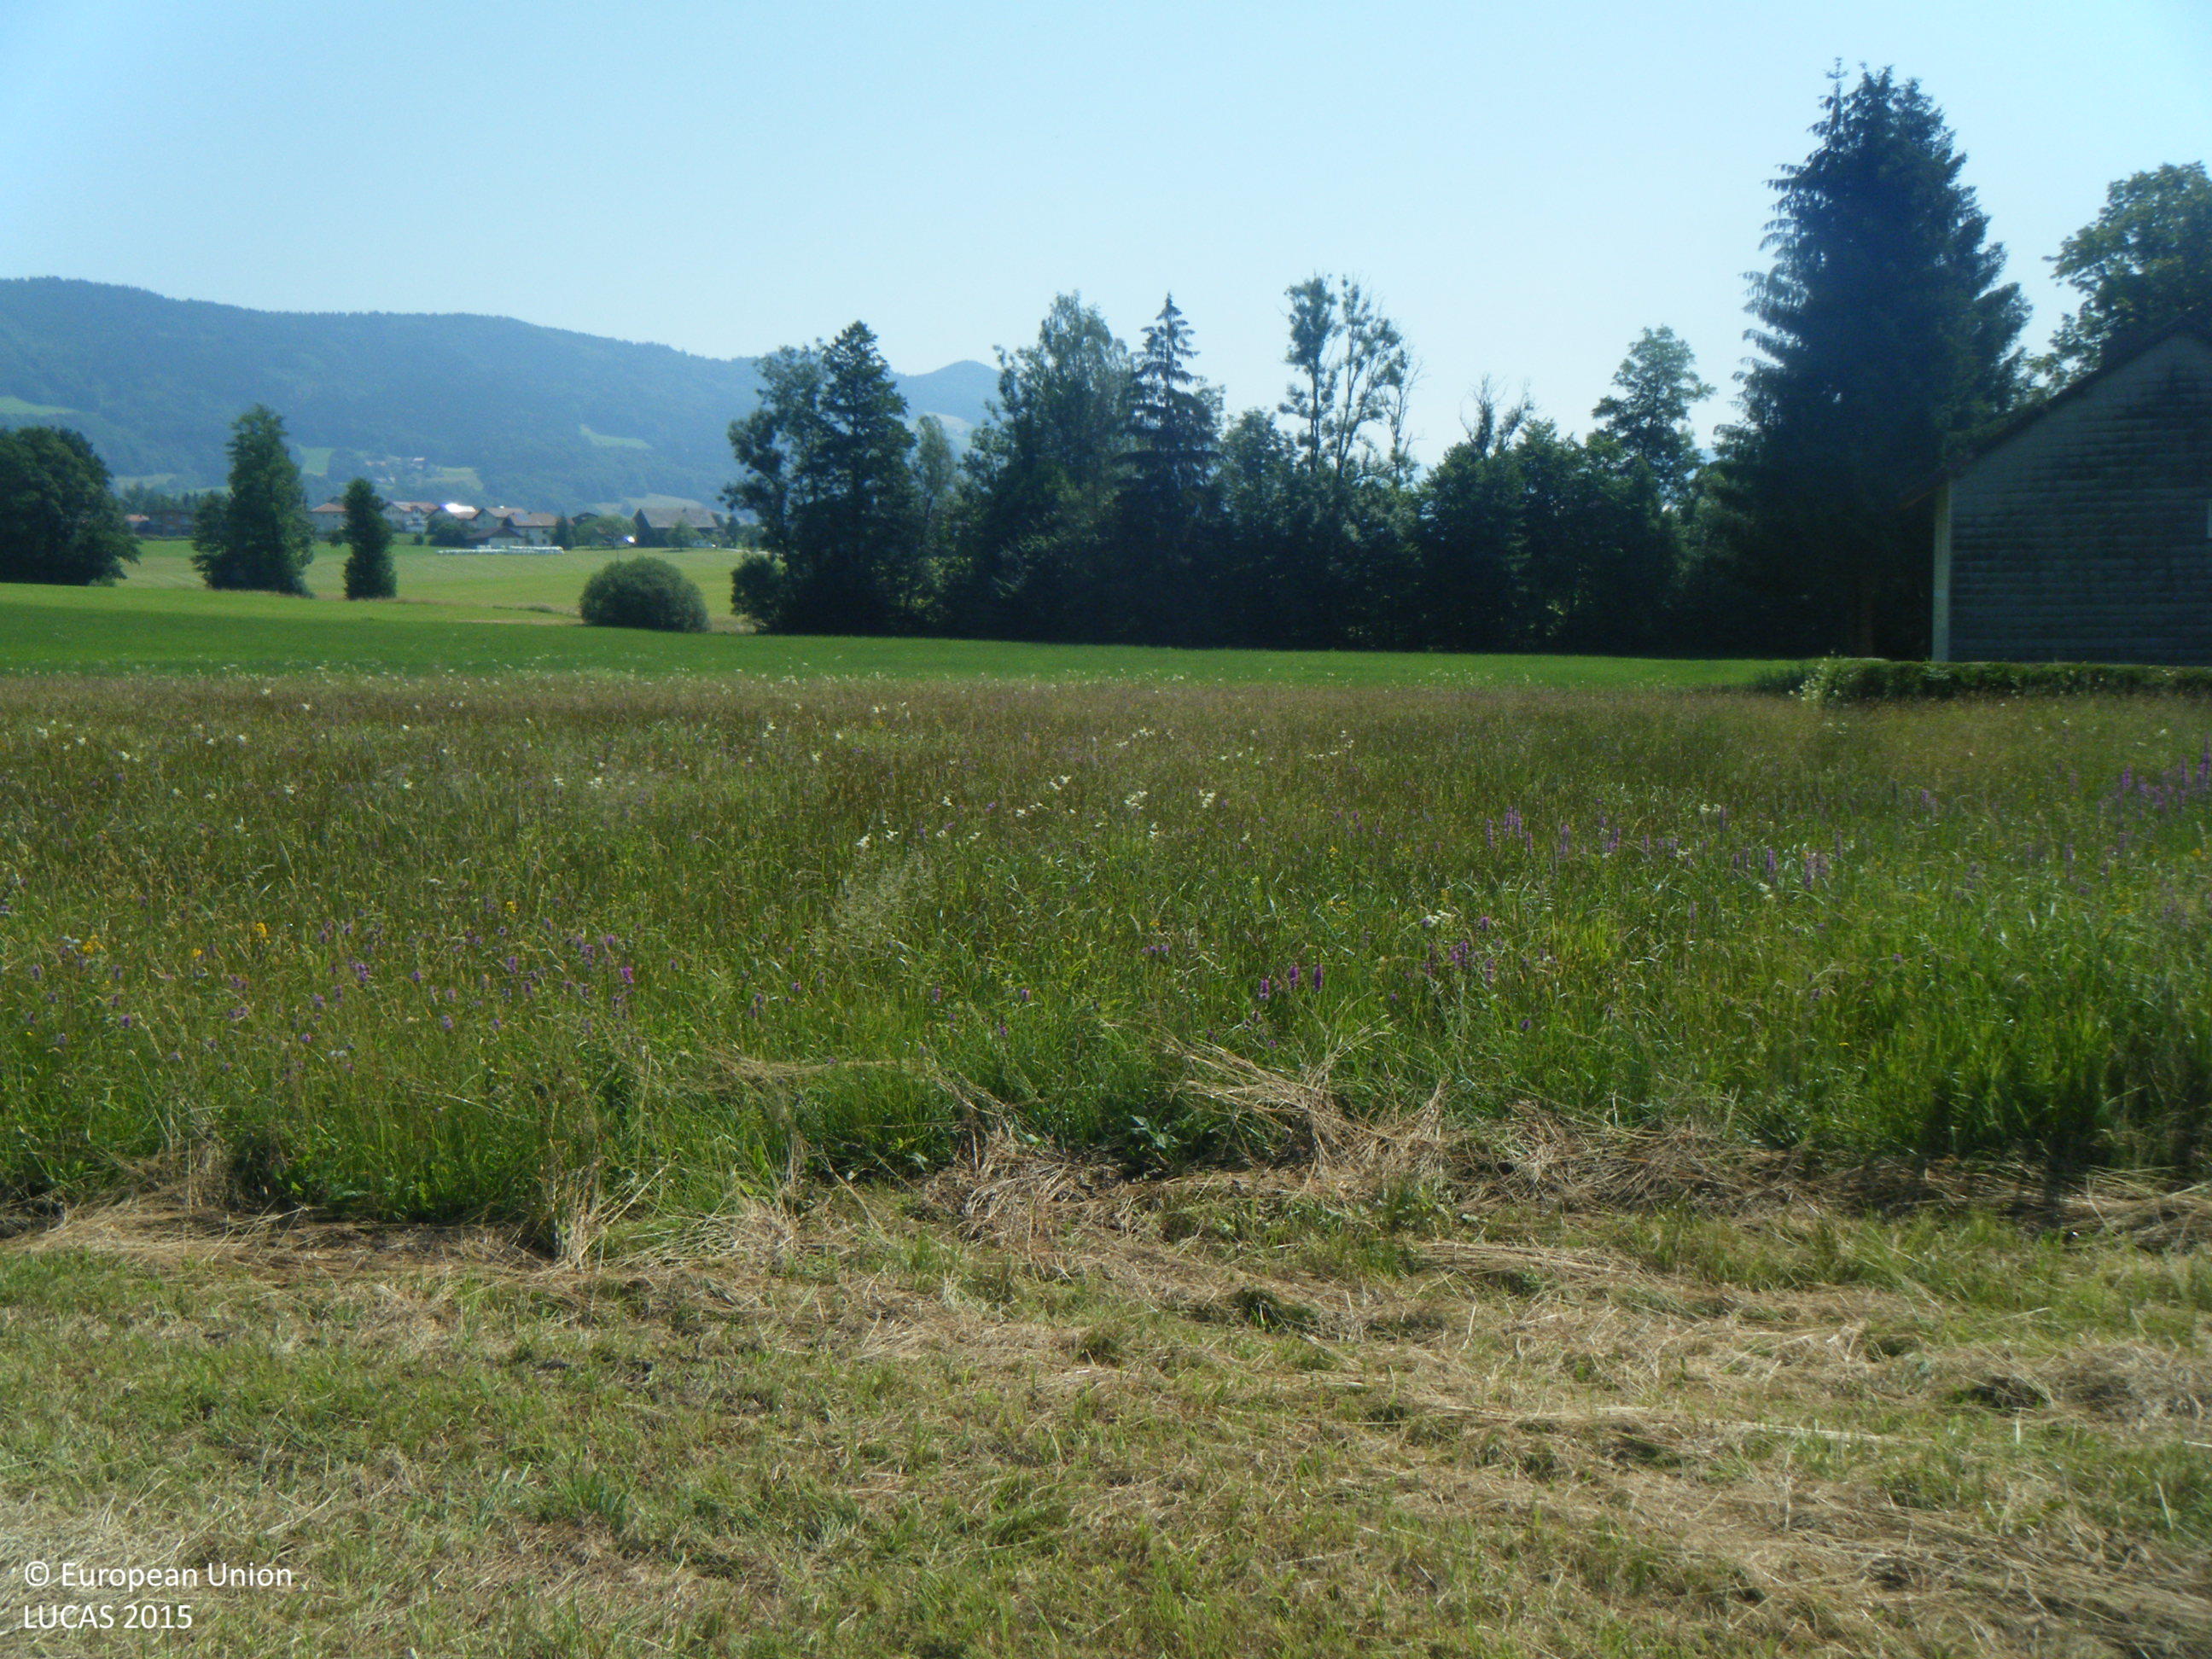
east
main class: Grassland
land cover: Grassland without tree/shrub cover
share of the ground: > 75 %
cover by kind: herbaceous plants 100 %
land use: Agriculture (excluding fallow land and kitchen gardens)
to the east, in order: Grassland without tree/shrub cover; Ditches and canals; Grassland without tree/shrub cover; Broadleaved woodland; Rivers and streams; Groves; Grassland without tree/shrub cover
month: July
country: AT
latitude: 47.8492
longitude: 13.3263
